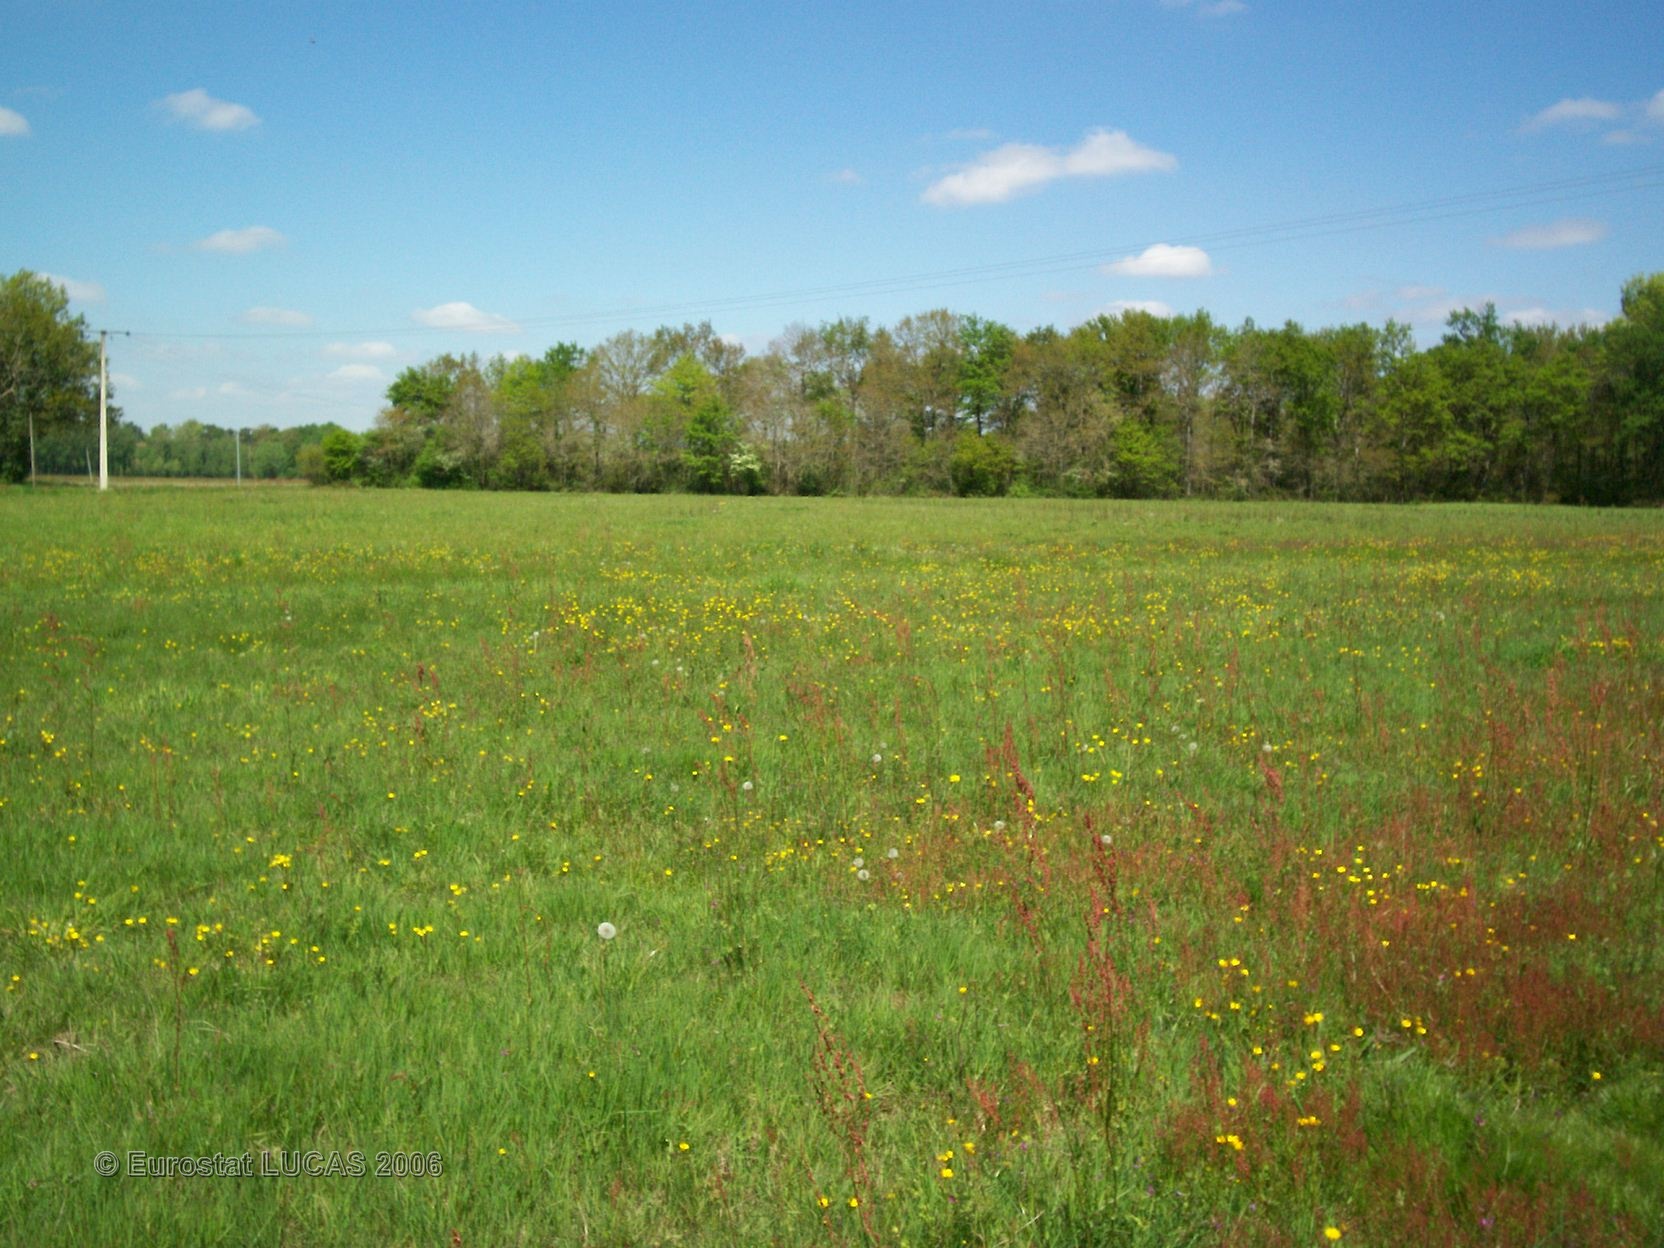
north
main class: Grassland
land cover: Grassland without tree/shrub cover
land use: Agriculture (excluding fallow land and kitchen gardens)
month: April
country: FR
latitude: 43.7765
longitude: -0.7103
